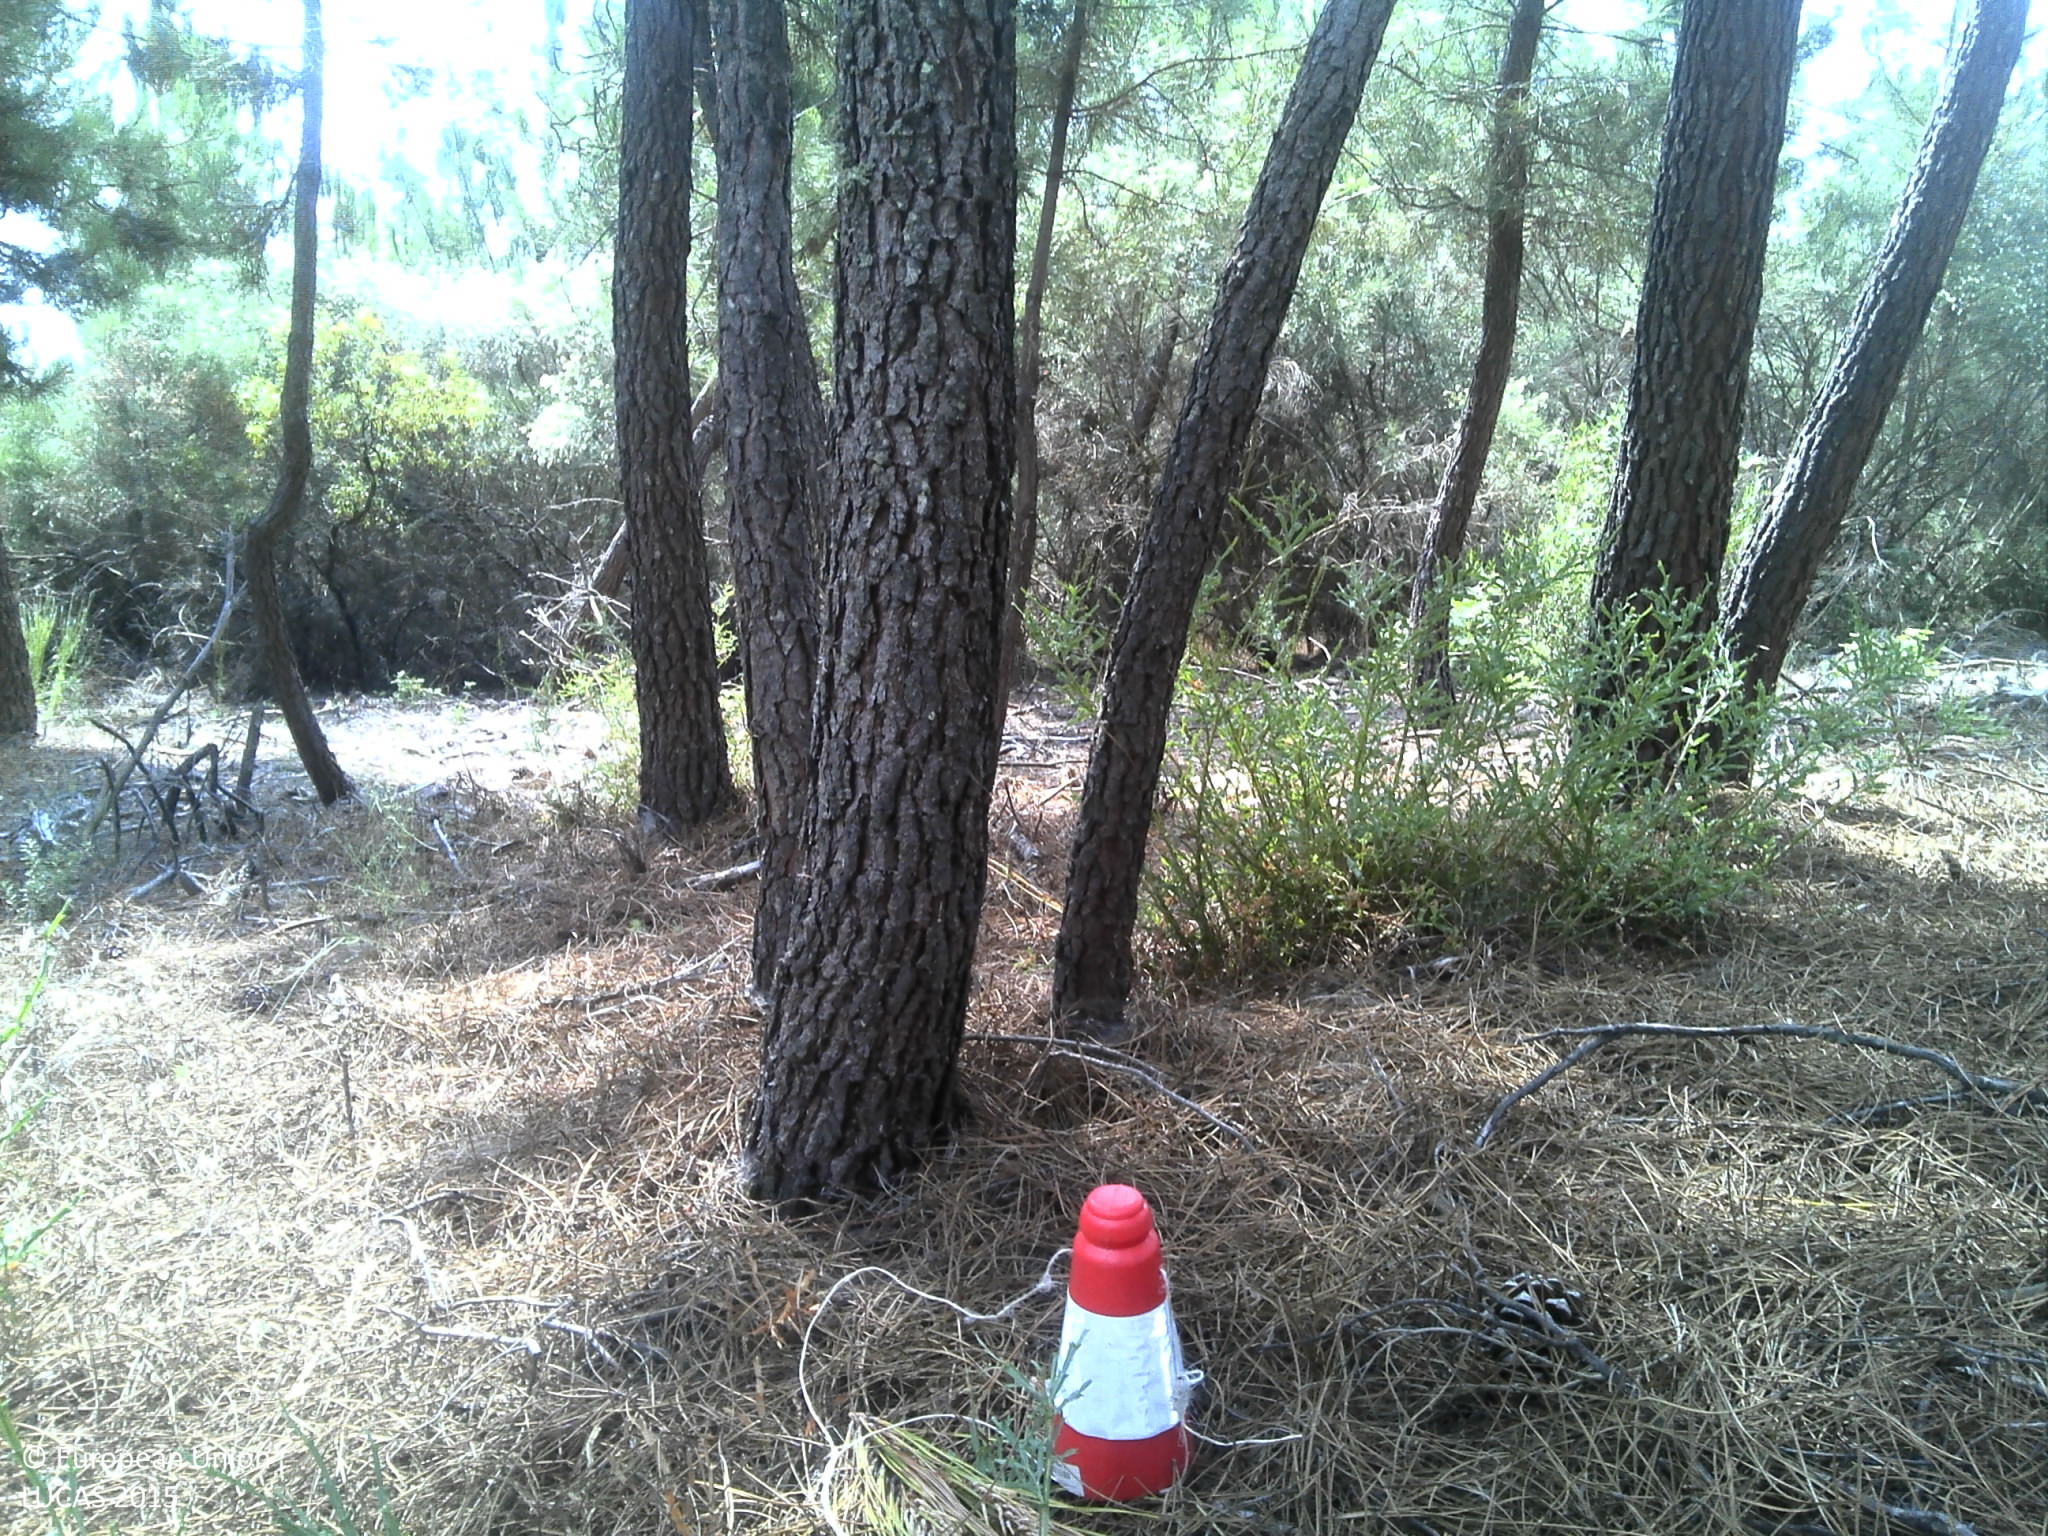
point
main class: Woodland
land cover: Pine dominated coniferous woodland
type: coniferous forest of the mediterranean region
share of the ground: 50 - 75 %
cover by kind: coniferous forest trees 50 %, shrubs 30 %, unconsolidated bare surface 15 %
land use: Forestry
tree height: > 5 m
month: June
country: PT
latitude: 40.2701
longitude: -7.2827
